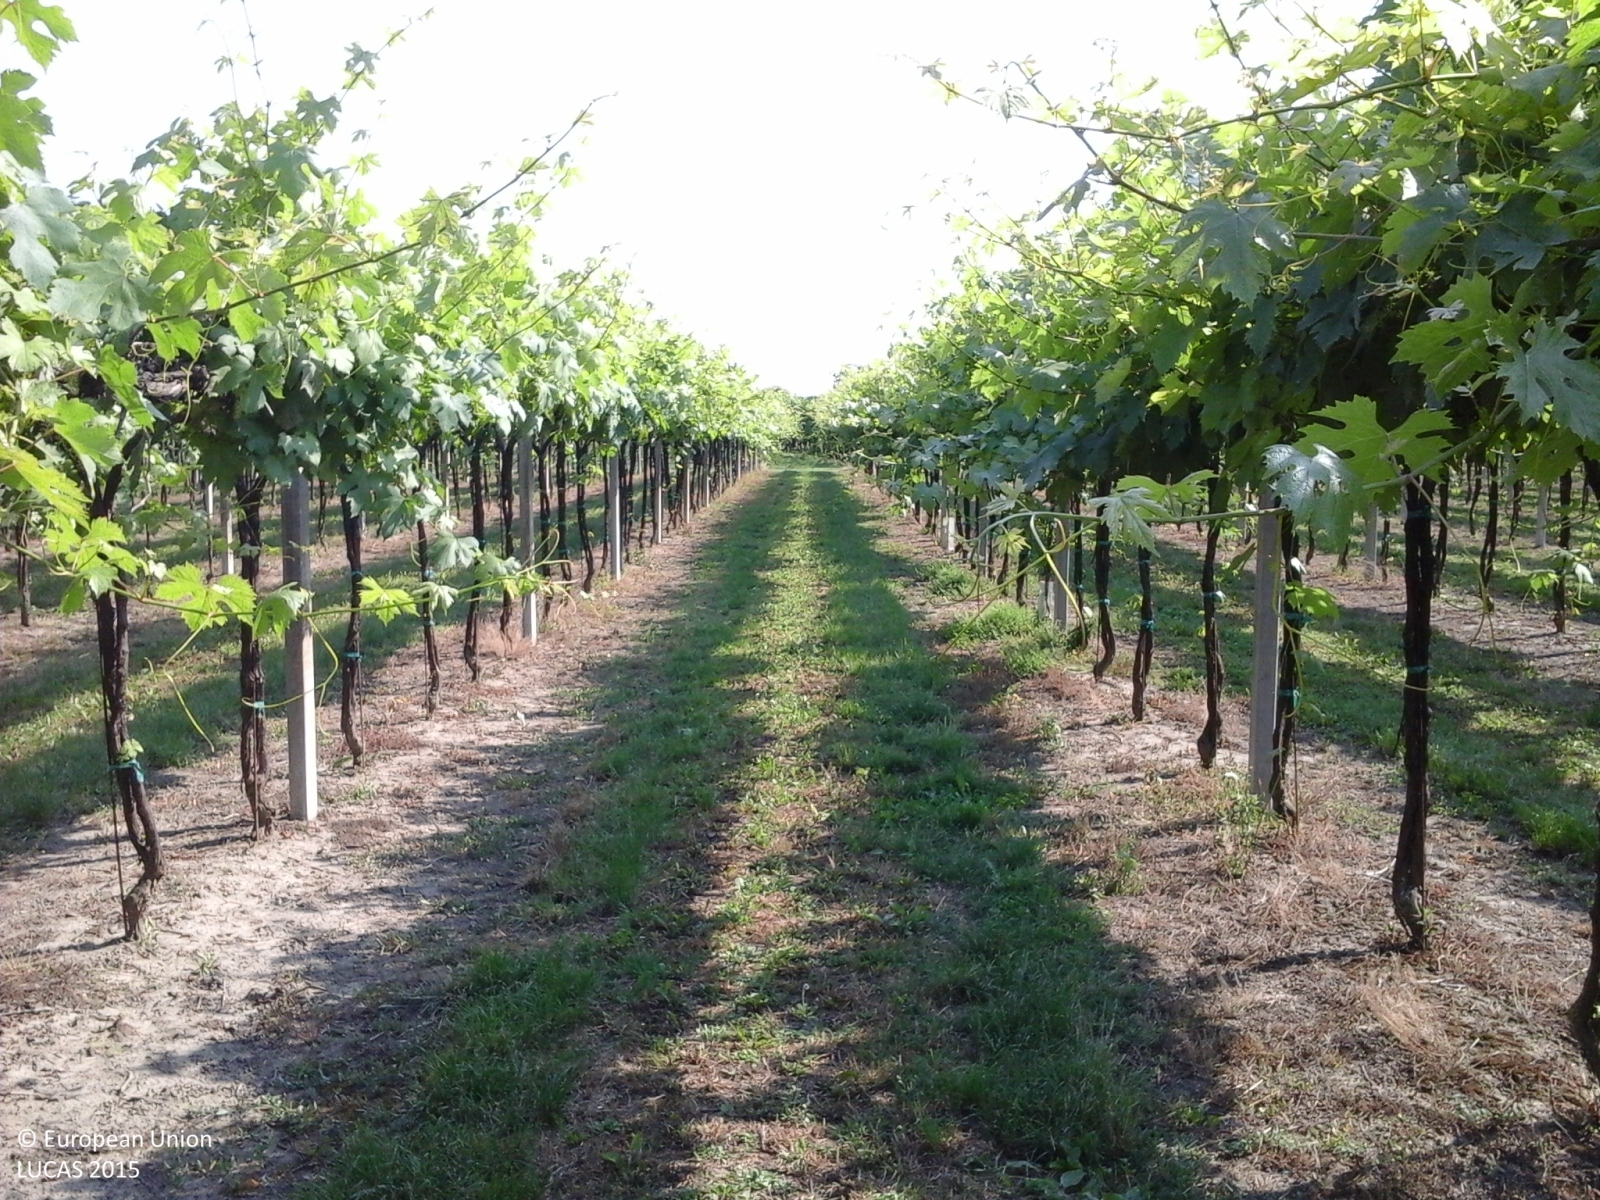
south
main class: Cropland
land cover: Vineyards
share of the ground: 25 - 50 %
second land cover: Grassland without tree/shrub cover
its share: 50 - 75 %
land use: Agriculture (excluding fallow land and kitchen gardens)
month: May
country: IT
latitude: 44.7627
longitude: 10.7439
